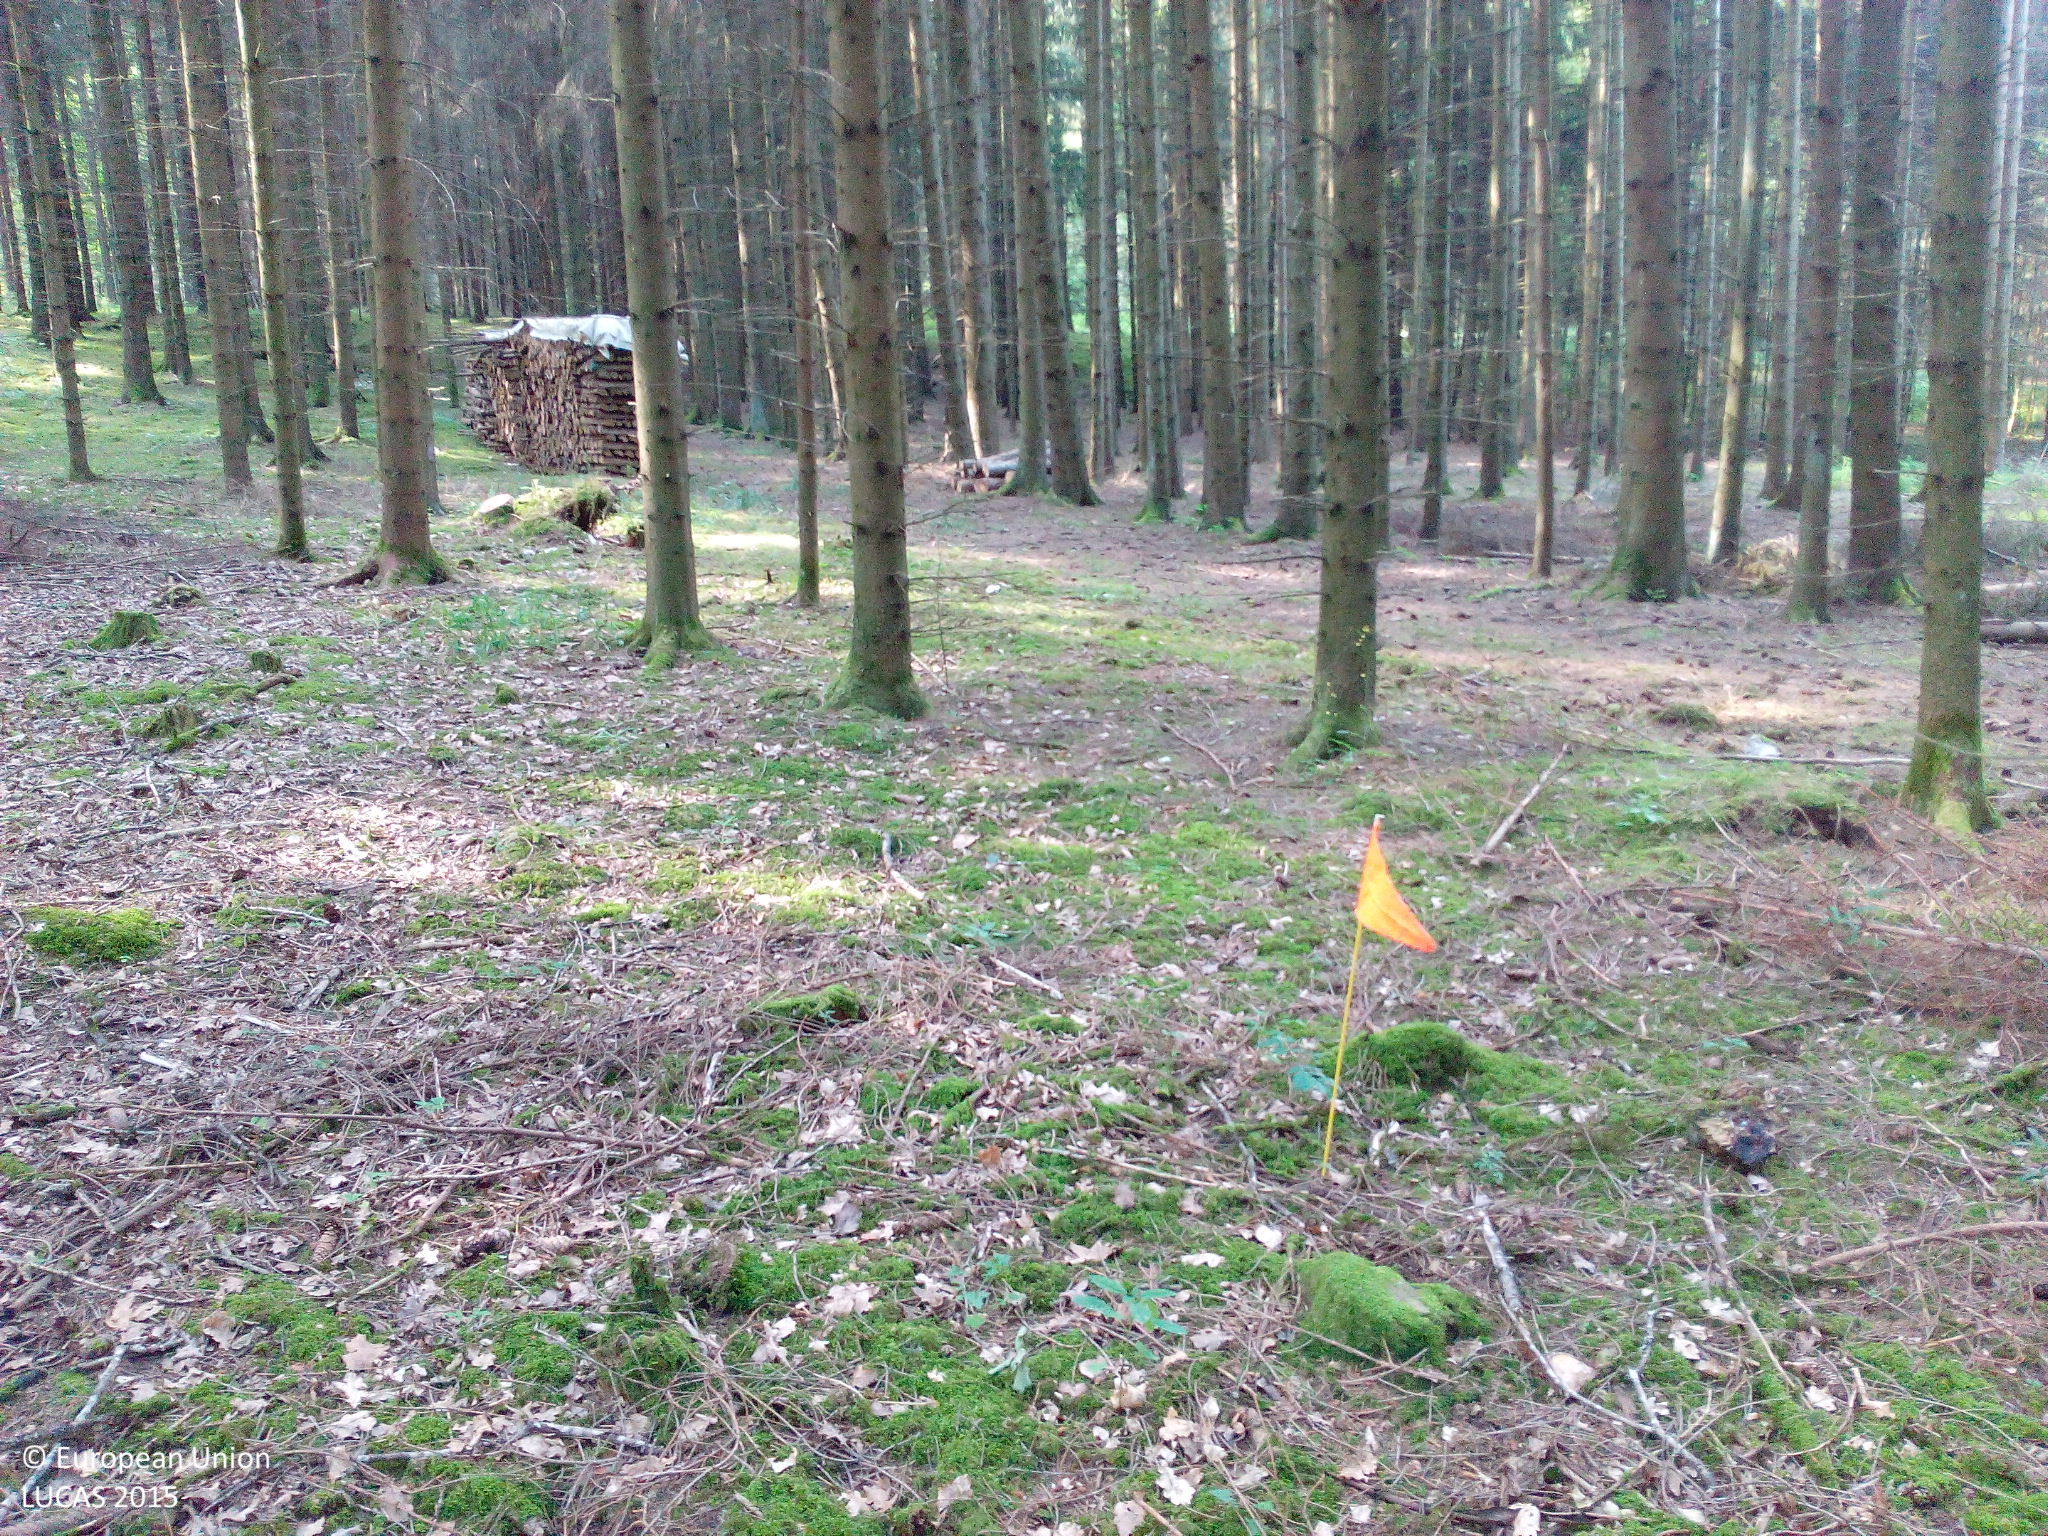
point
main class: Woodland
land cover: Spruce dominated coniferous woodland
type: hemiboreal forest and nemoral coniferous forest and mixed broadleaved-coniferous forest
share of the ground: > 75 %
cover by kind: coniferous forest trees 95 %, broadleaved forest trees 5 %
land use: Forestry
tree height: > 5 m
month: July
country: DE
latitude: 48.1854
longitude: 9.3144
